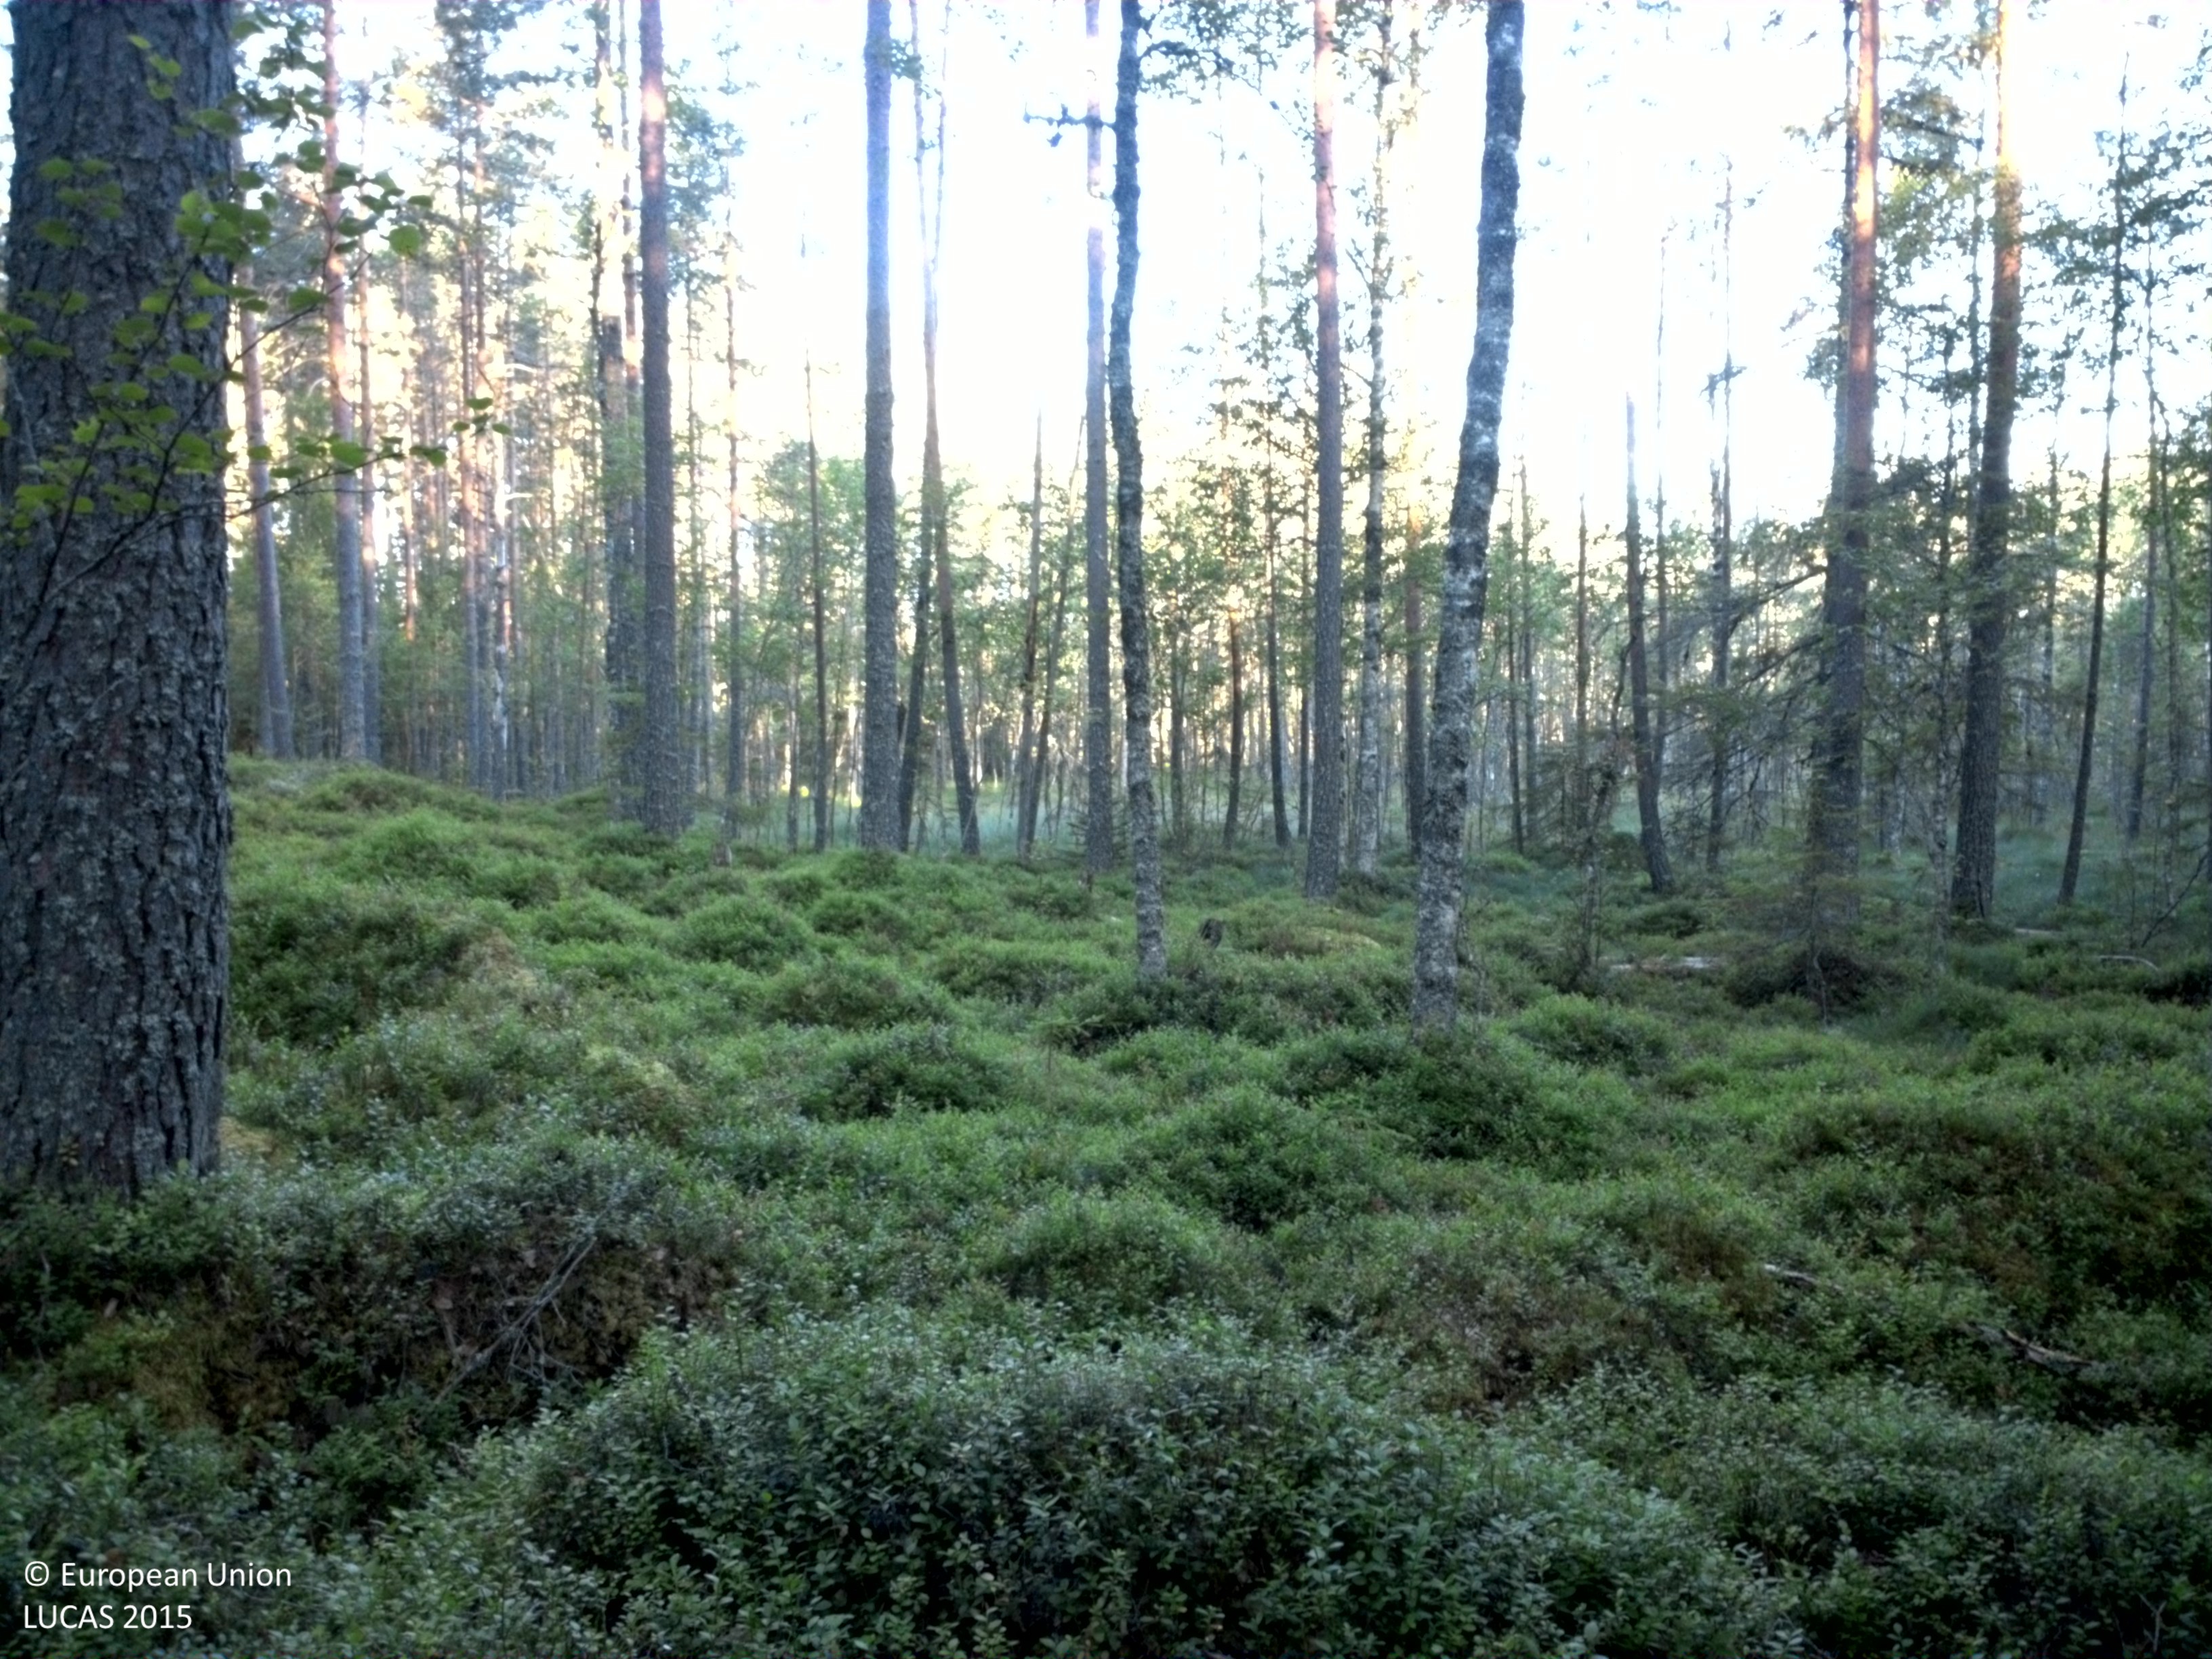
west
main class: Woodland
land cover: Pine dominated mixed woodland
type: boreal forest
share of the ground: 50 - 75 %
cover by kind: coniferous forest trees 50 %, broadleaved forest trees 25 %, shrubs 15 %, lichens and mosses 10 %
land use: Forestry
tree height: > 5 m
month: August
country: SE
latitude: 60.1980
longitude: 13.2197
